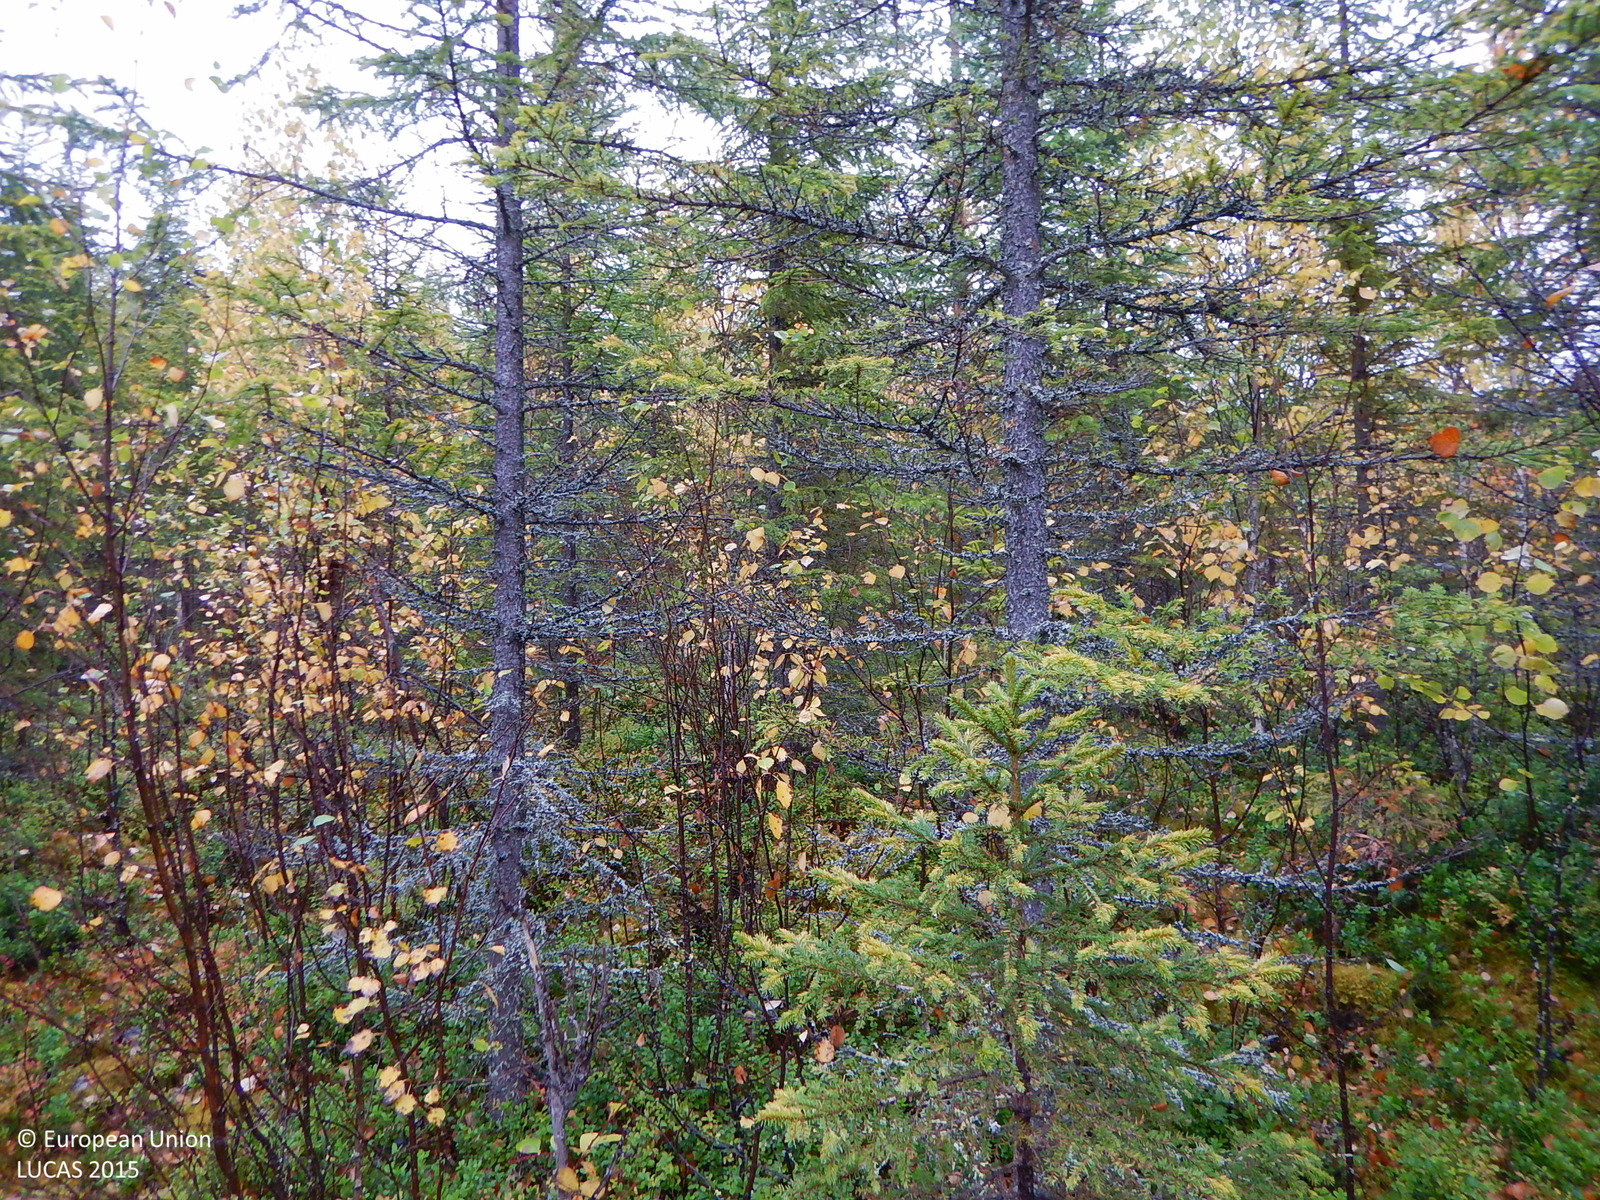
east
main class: Woodland
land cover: Spruce dominated coniferous woodland
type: boreal forest
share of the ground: 50 - 75 %
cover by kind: coniferous forest trees 55 %, lichens and mosses 20 %, shrubs 15 %, broadleaved forest trees 5 %, herbaceous plants 5 %
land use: Forestry
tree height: < 5 m
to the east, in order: Spruce dominated coniferous woodland; Spruce dominated mixed woodland; Pine dominated coniferous woodland
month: September
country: SE
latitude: 65.0371
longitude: 18.9478
